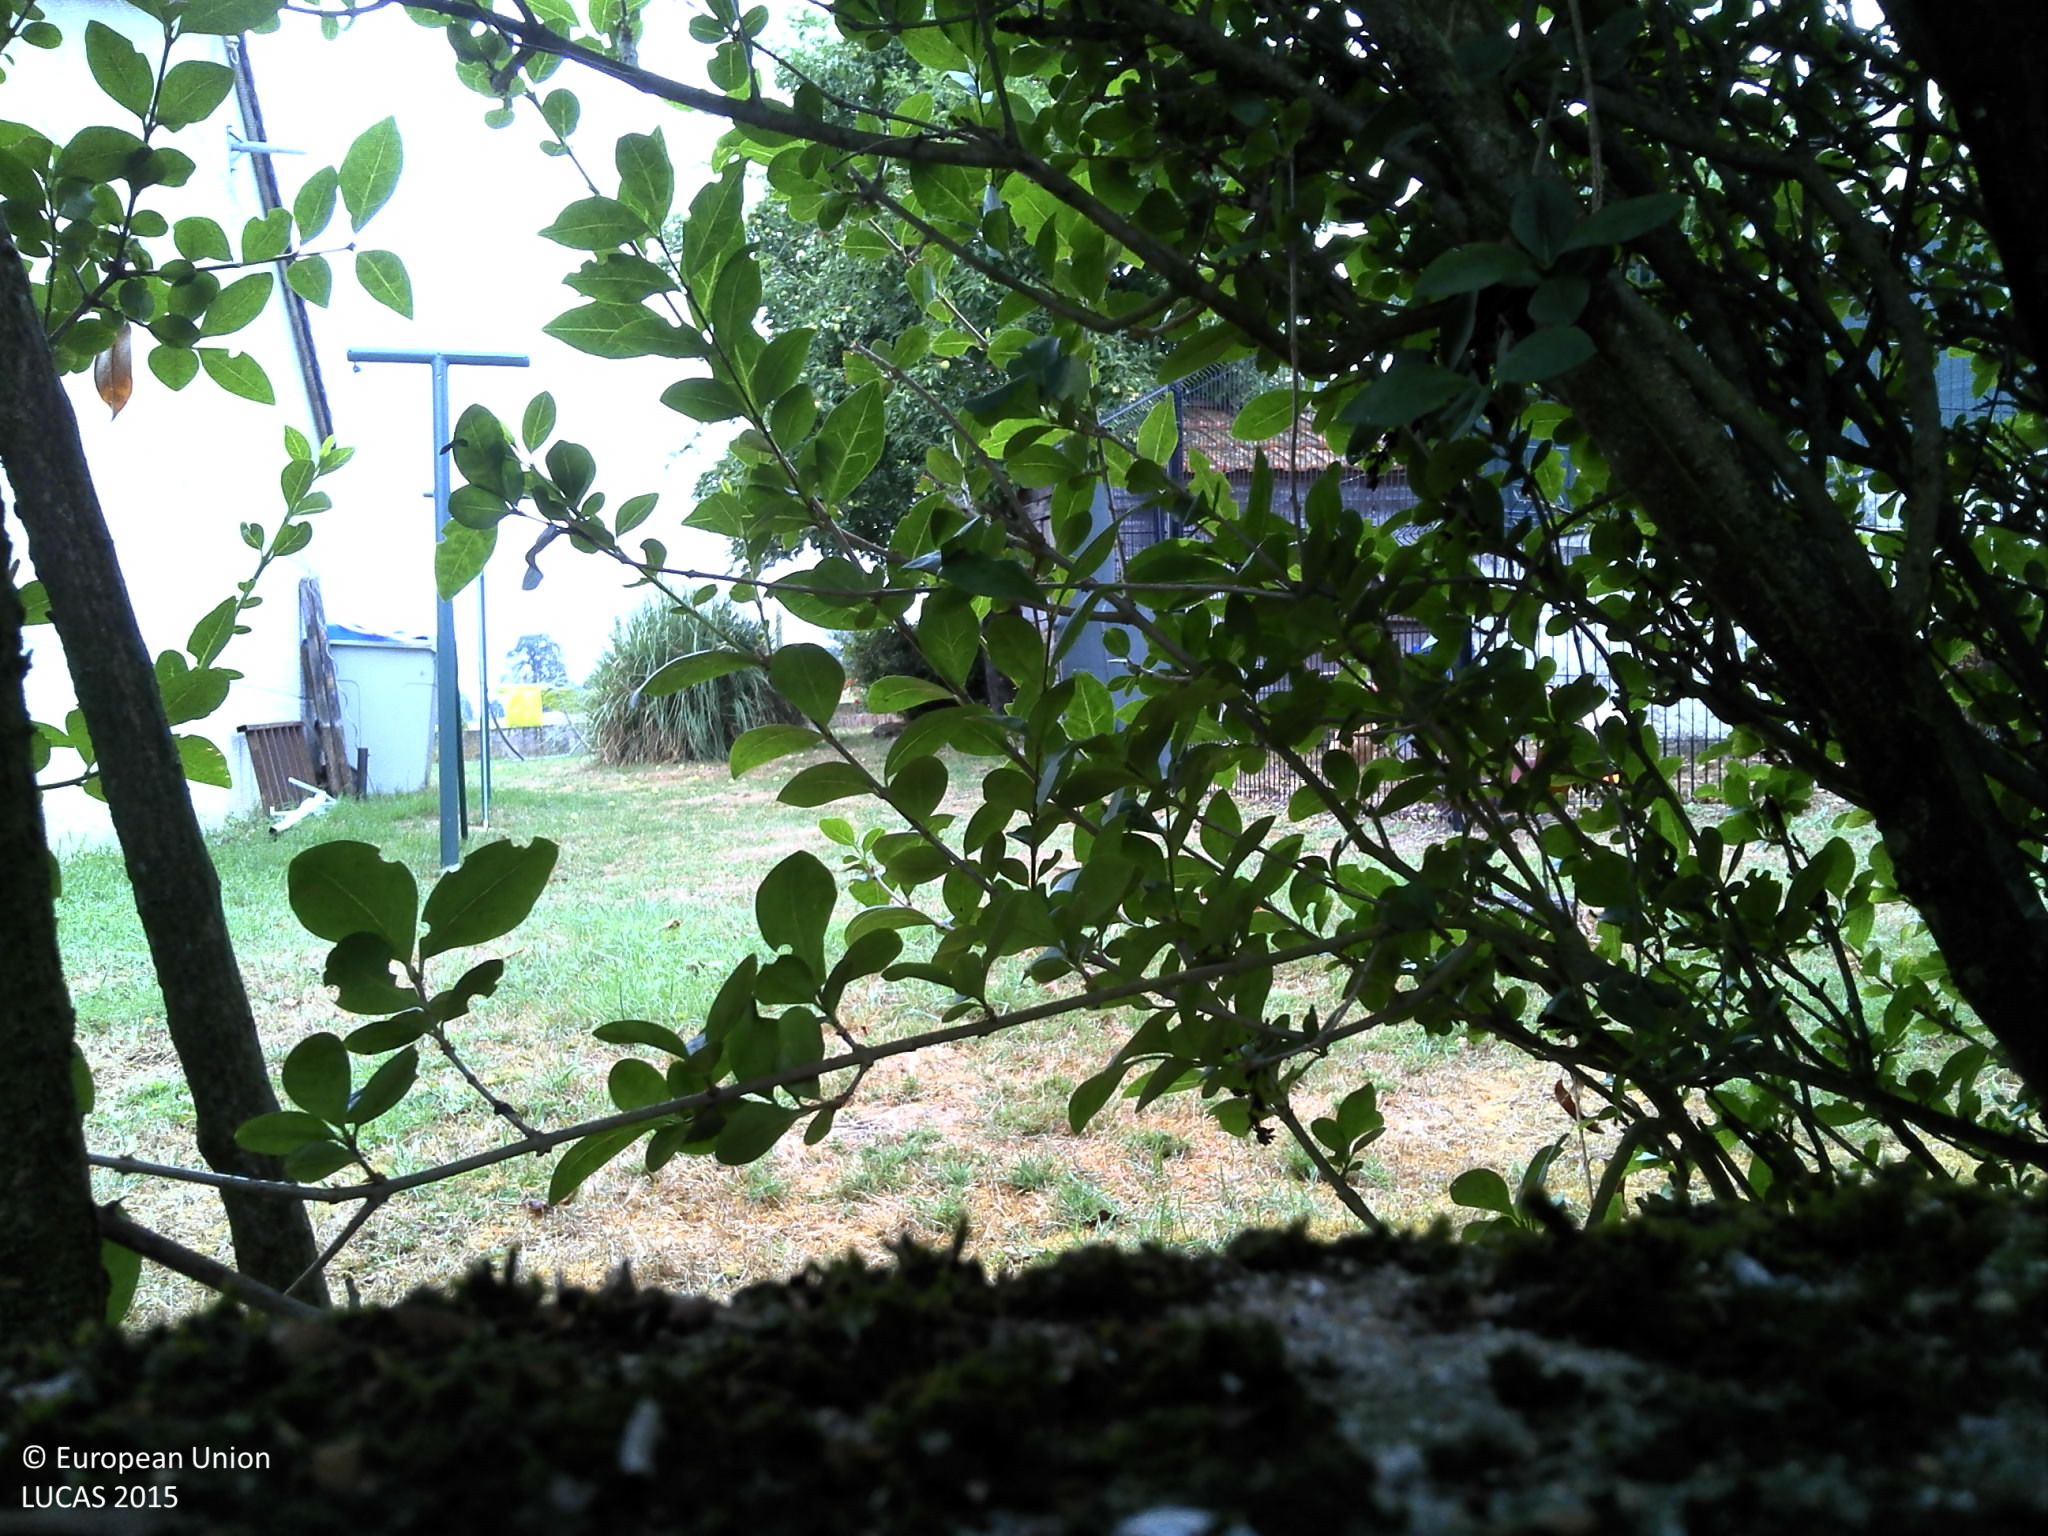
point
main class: Grassland
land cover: Grassland without tree/shrub cover
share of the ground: > 75 %
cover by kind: herbaceous plants 100 %
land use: Residential
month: August
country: FR
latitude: 46.1514
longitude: 4.0842
